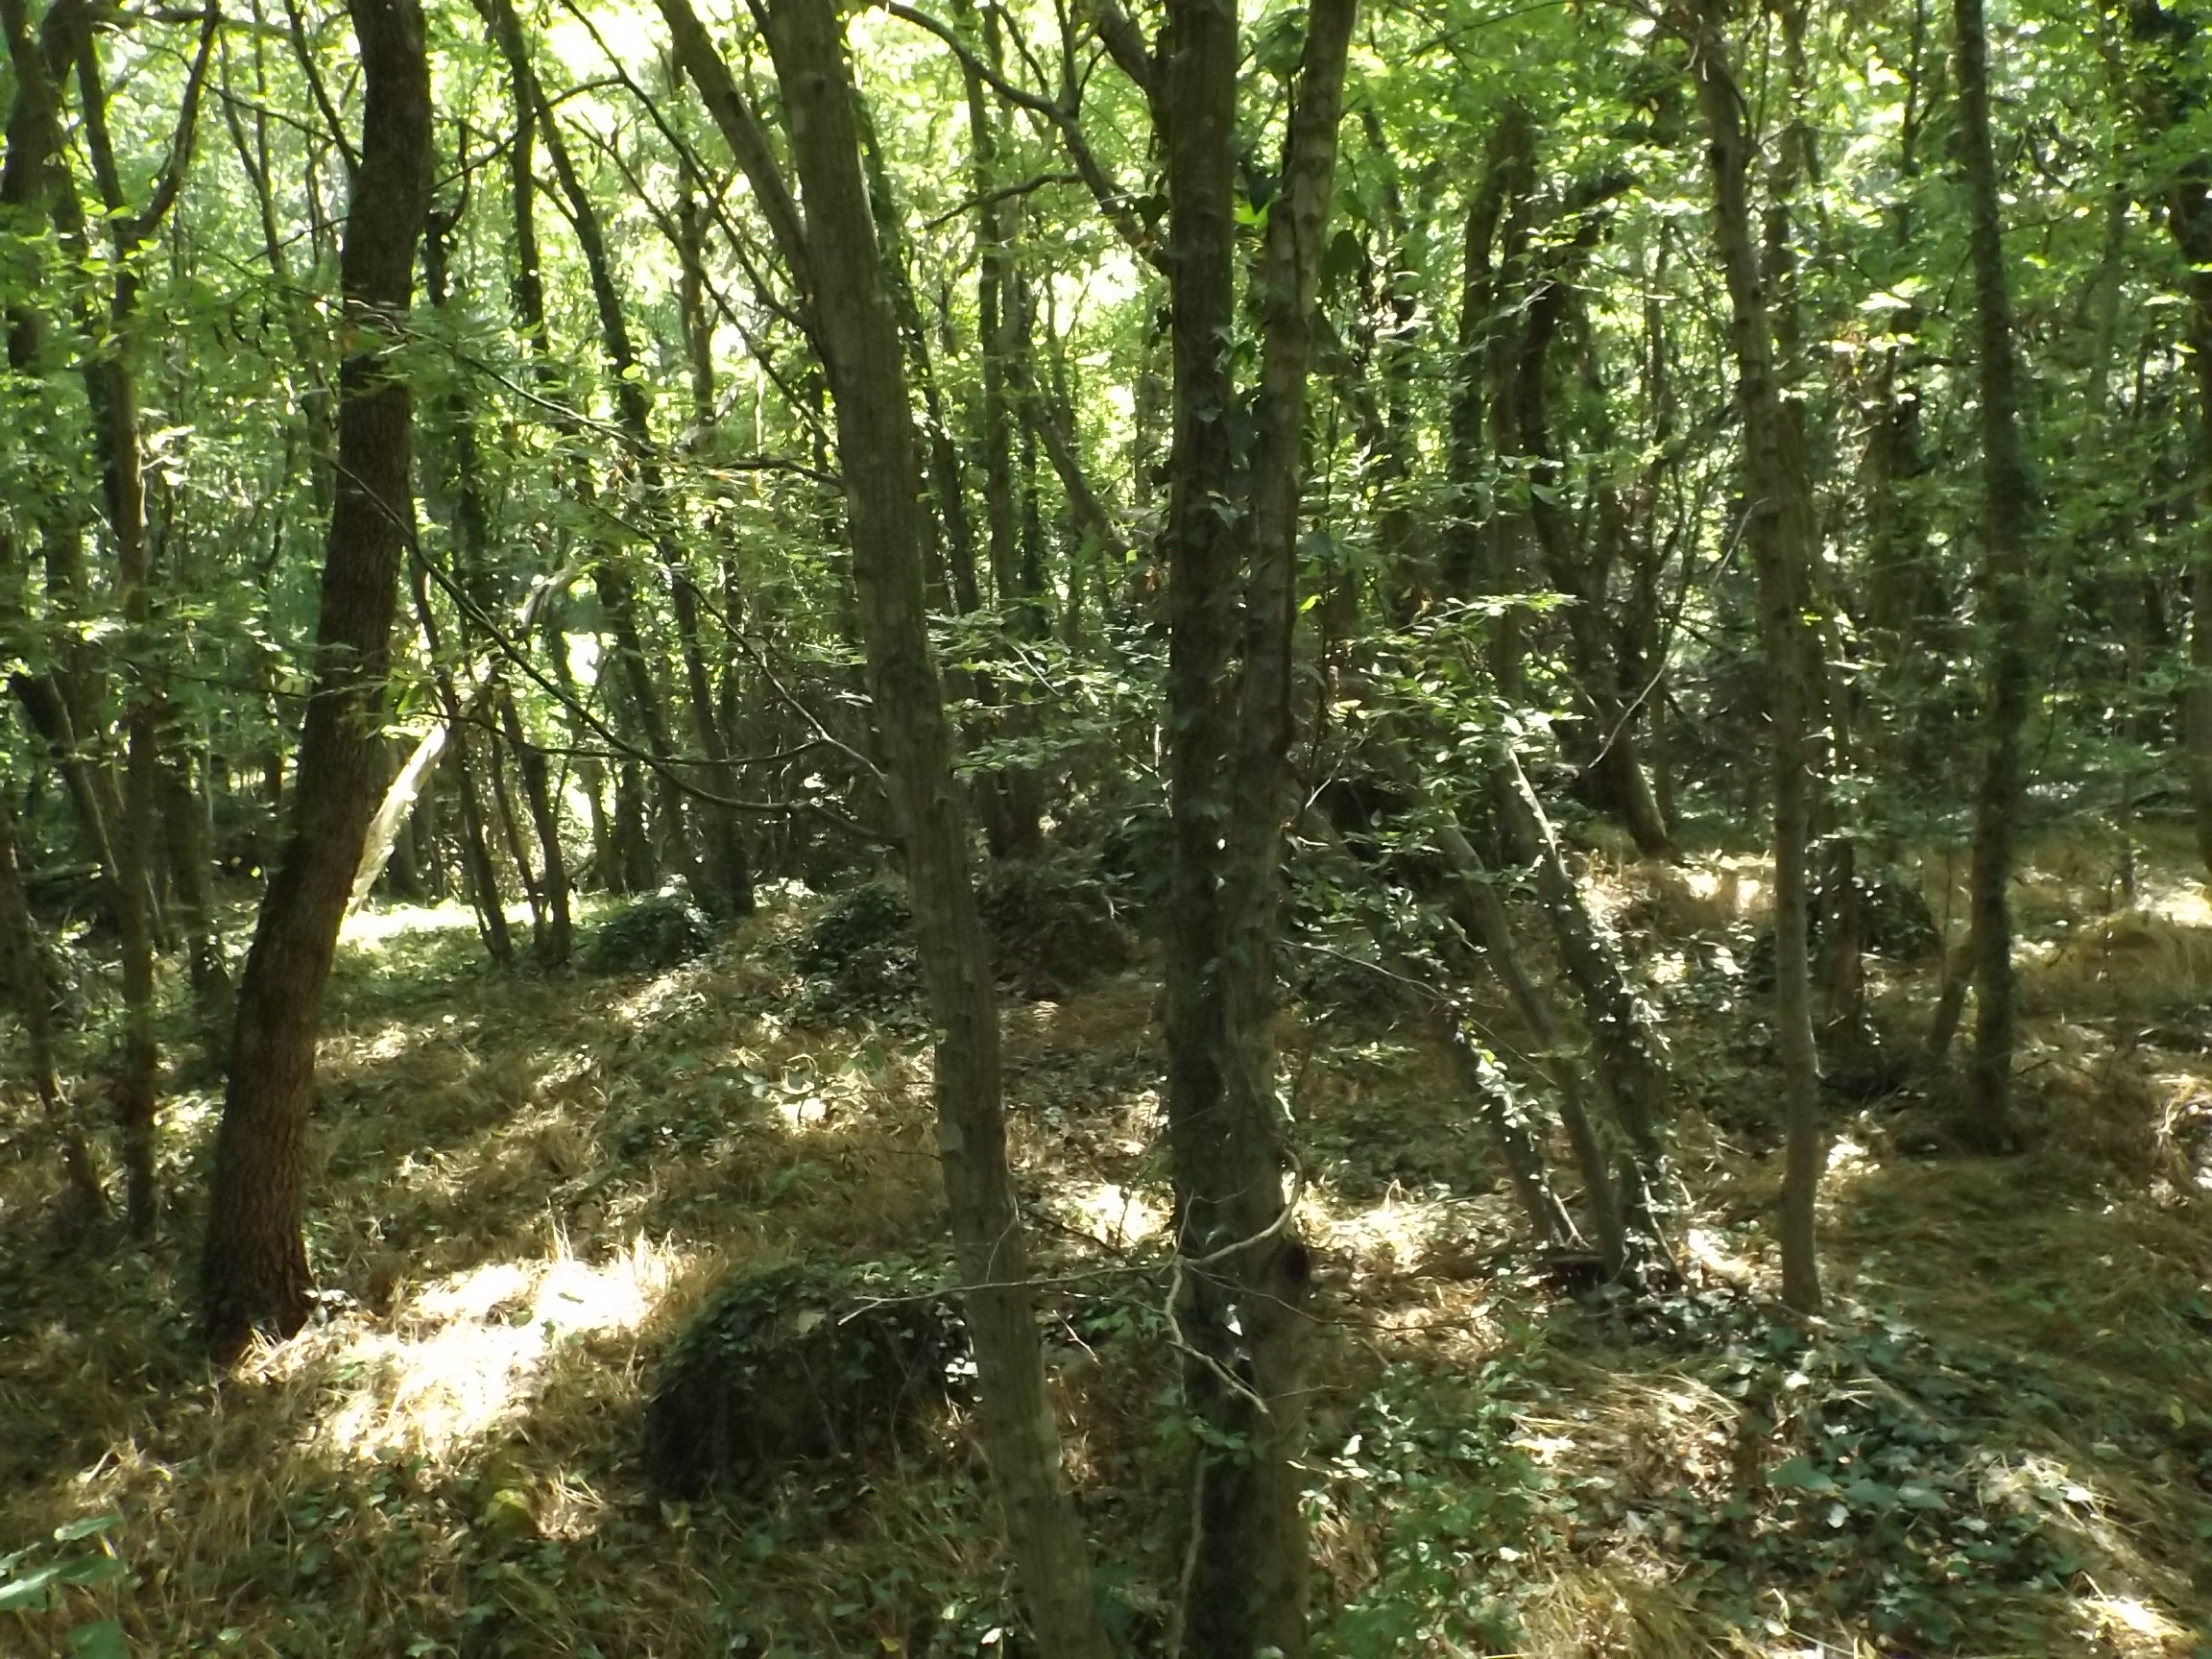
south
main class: Woodland
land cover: Broadleaved woodland
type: beech forest
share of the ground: > 75 %
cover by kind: broadleaved forest trees 100 %
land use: Forestry
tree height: > 5 m
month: August
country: BG
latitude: 43.2731
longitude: 28.0216
